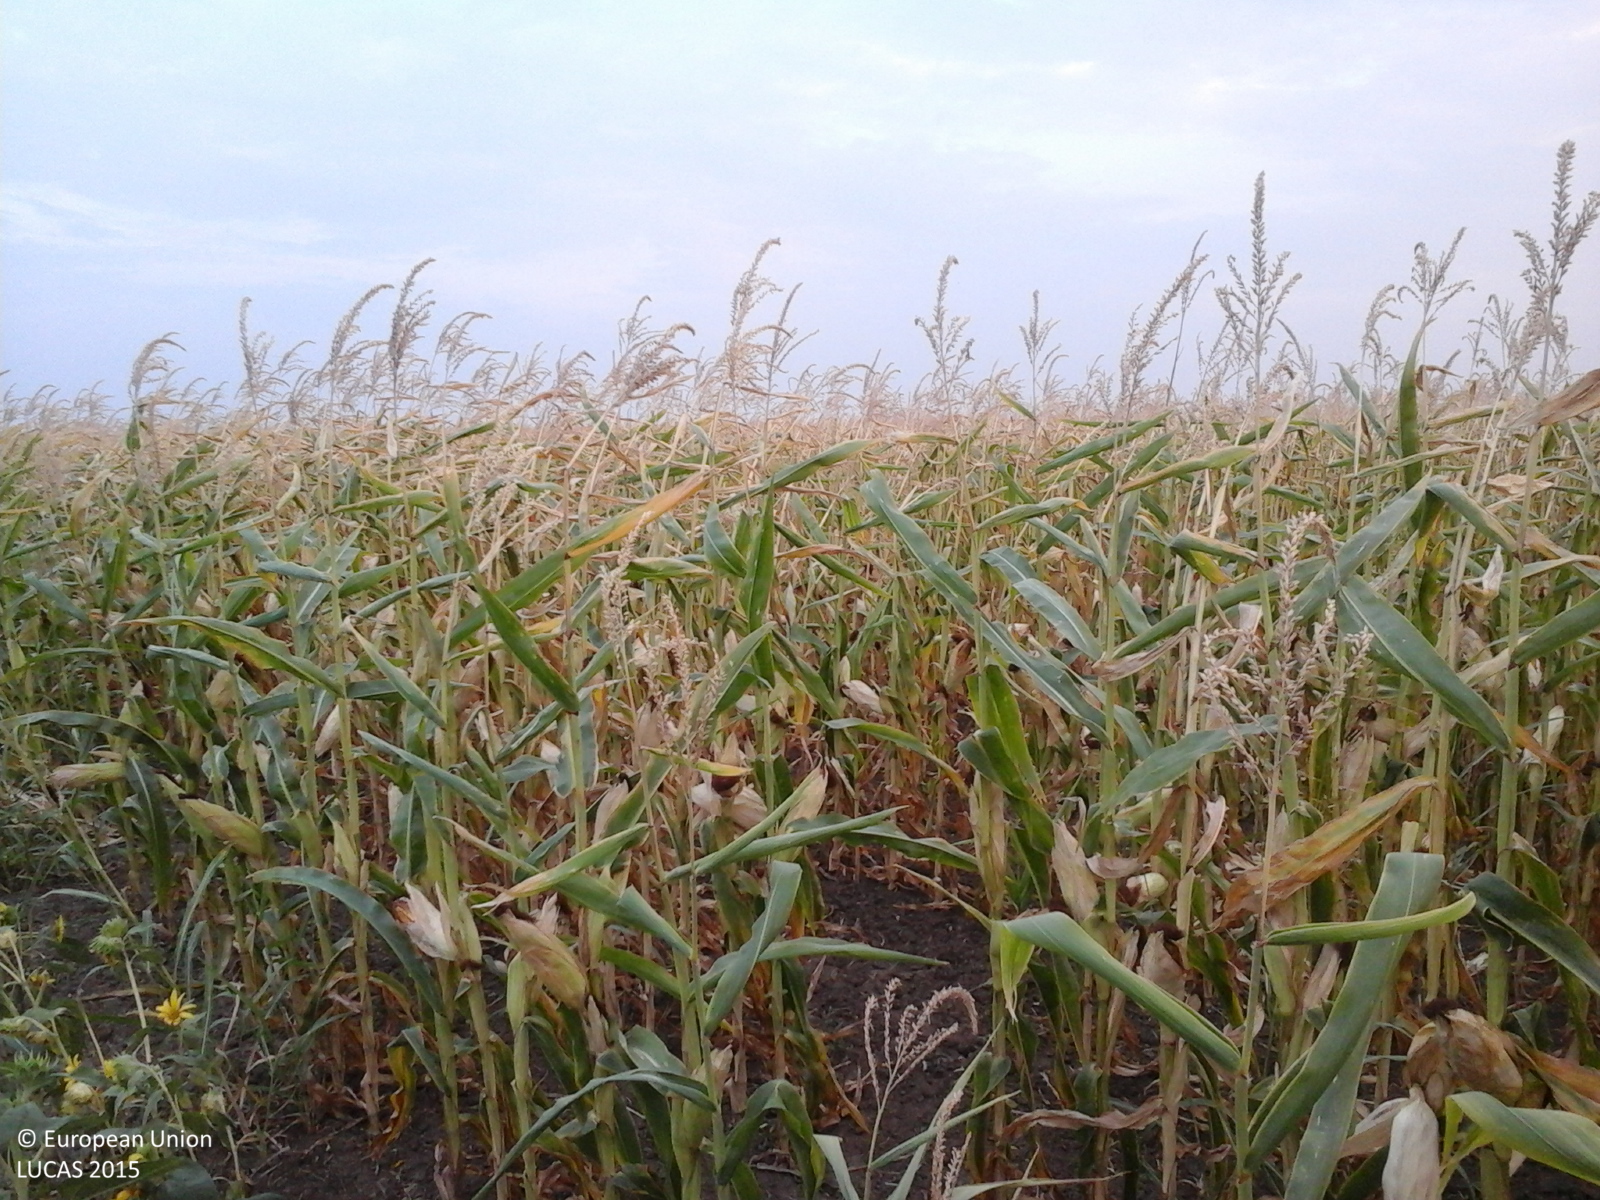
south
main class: Cropland
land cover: Maize
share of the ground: > 75 %
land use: Agriculture (excluding fallow land and kitchen gardens)
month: August
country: RO
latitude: 45.0142
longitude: 27.4419
